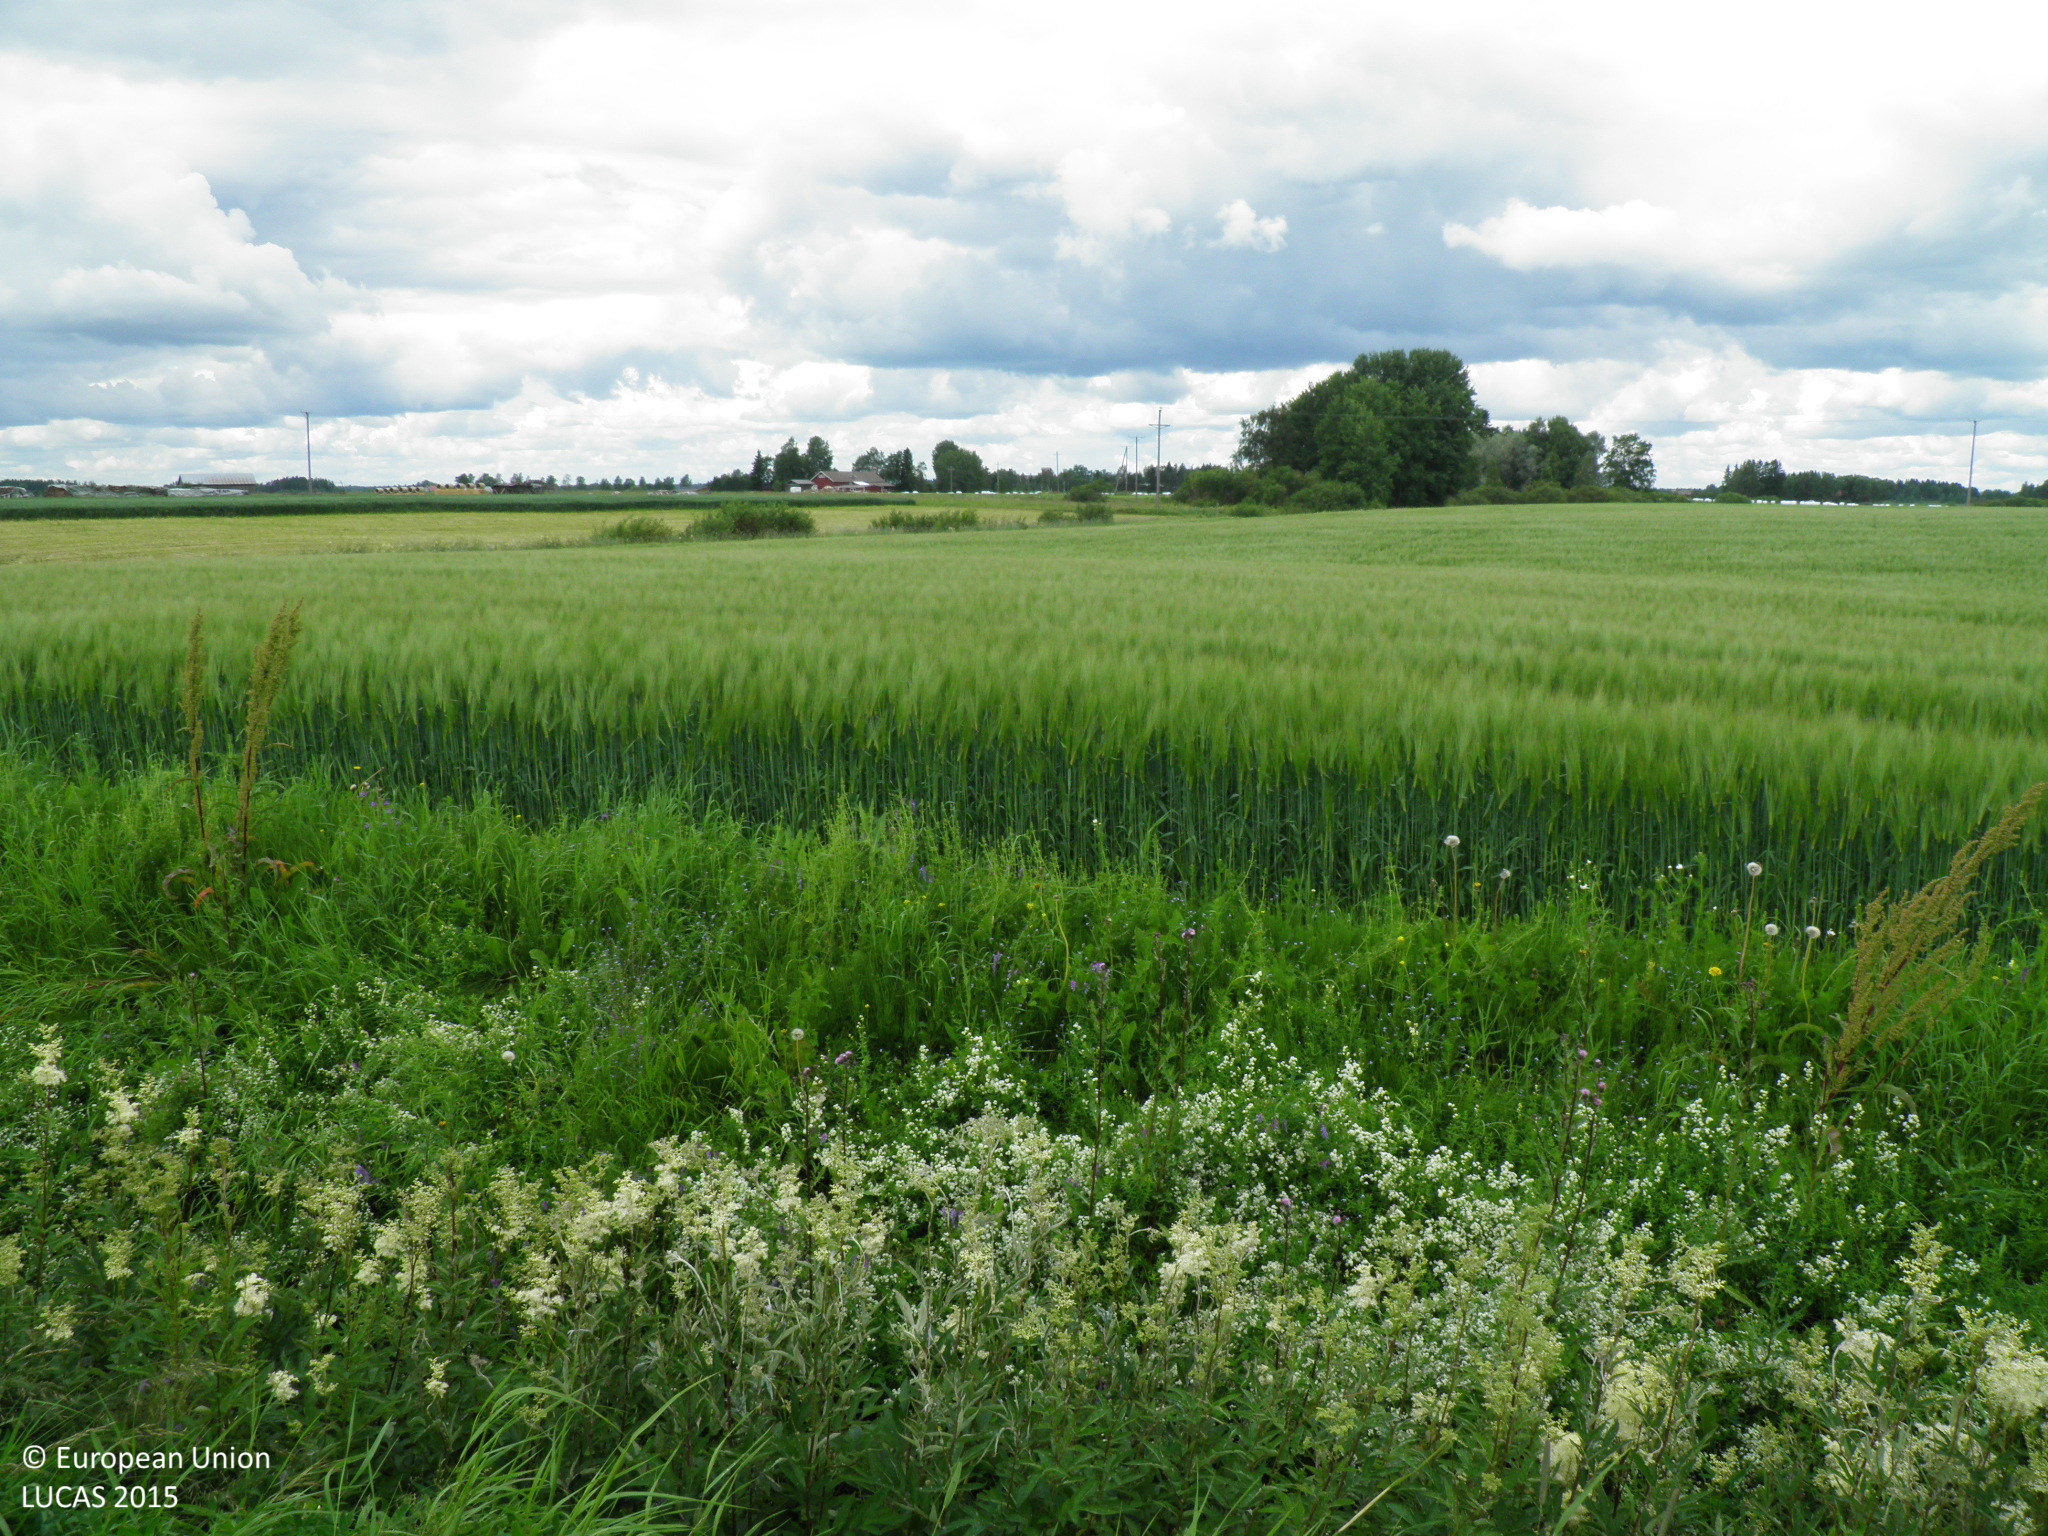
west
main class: Cropland
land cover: Oats
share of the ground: > 75 %
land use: Agriculture (excluding fallow land and kitchen gardens)
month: July
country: FI
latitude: 60.7838
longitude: 22.9874
